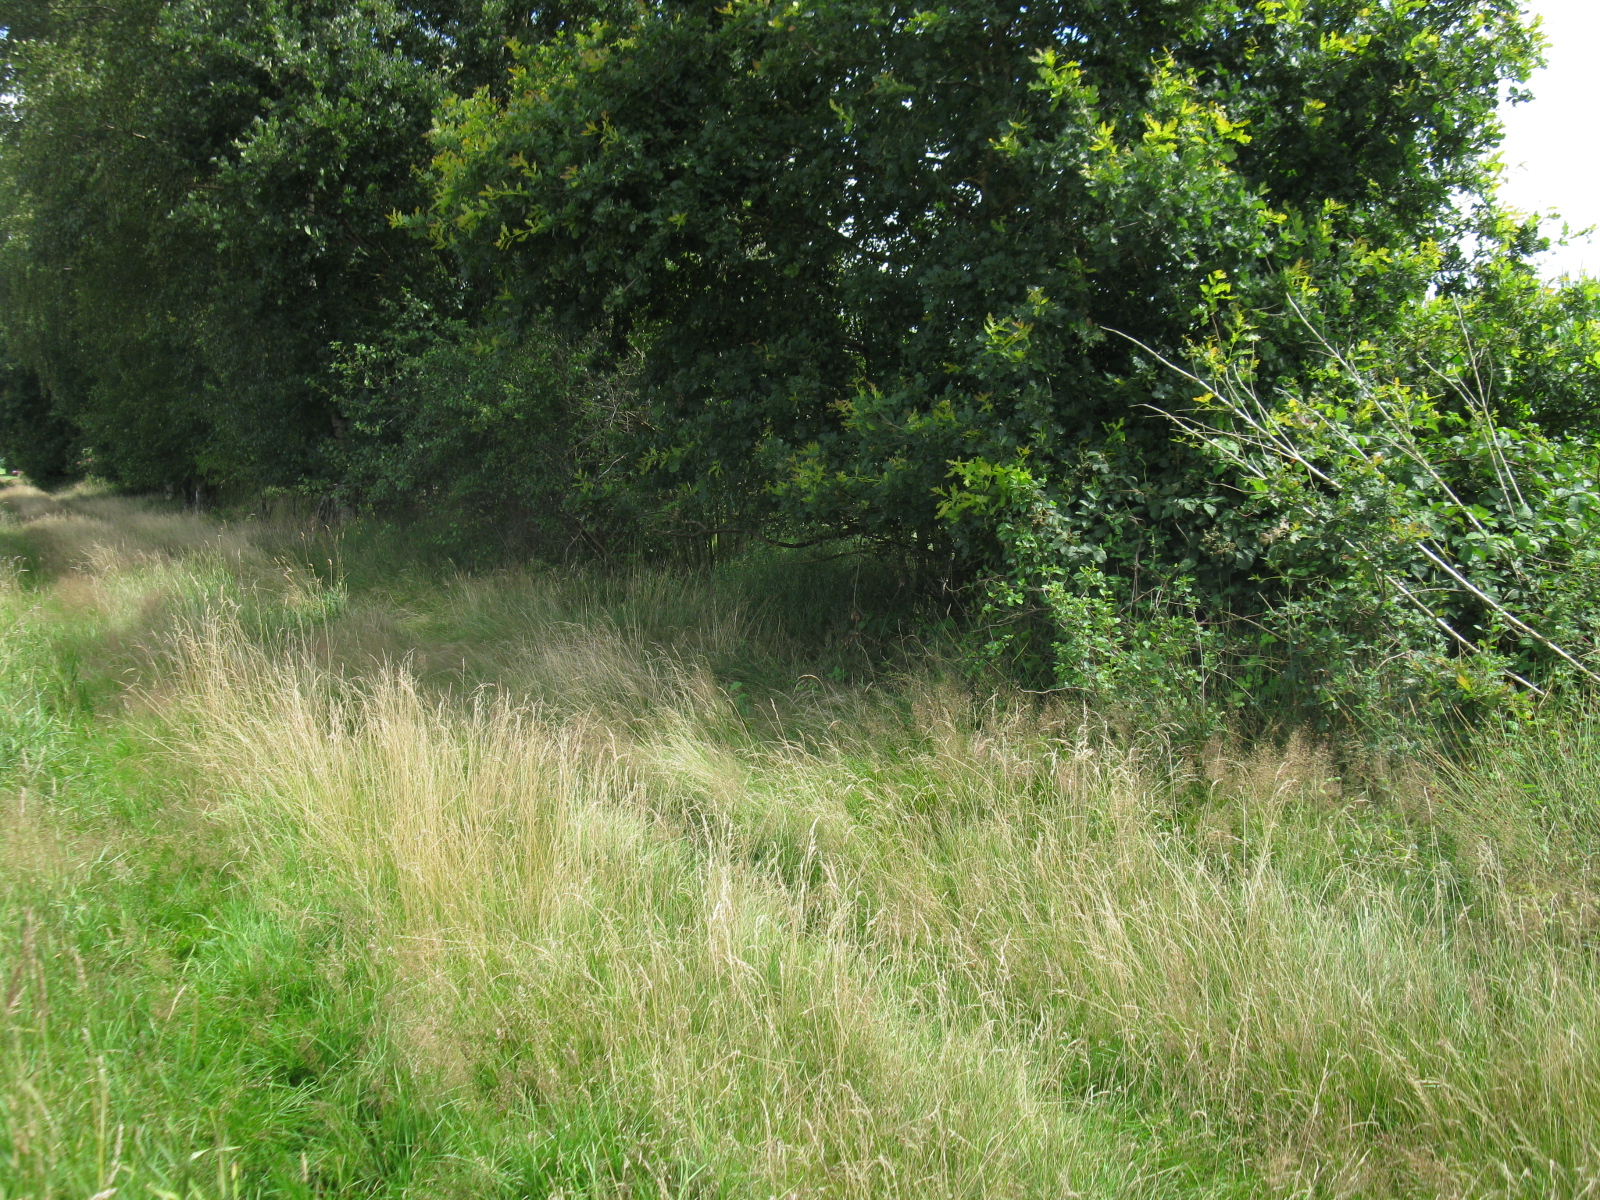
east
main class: Cropland
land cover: Rye
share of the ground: > 75 %
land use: Agriculture (excluding fallow land and kitchen gardens)
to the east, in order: Rye; Ditches and canals; Rye; Tracks; Broadleaved woodland; Maize
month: July
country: DE
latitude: 52.9616
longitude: 8.5267
